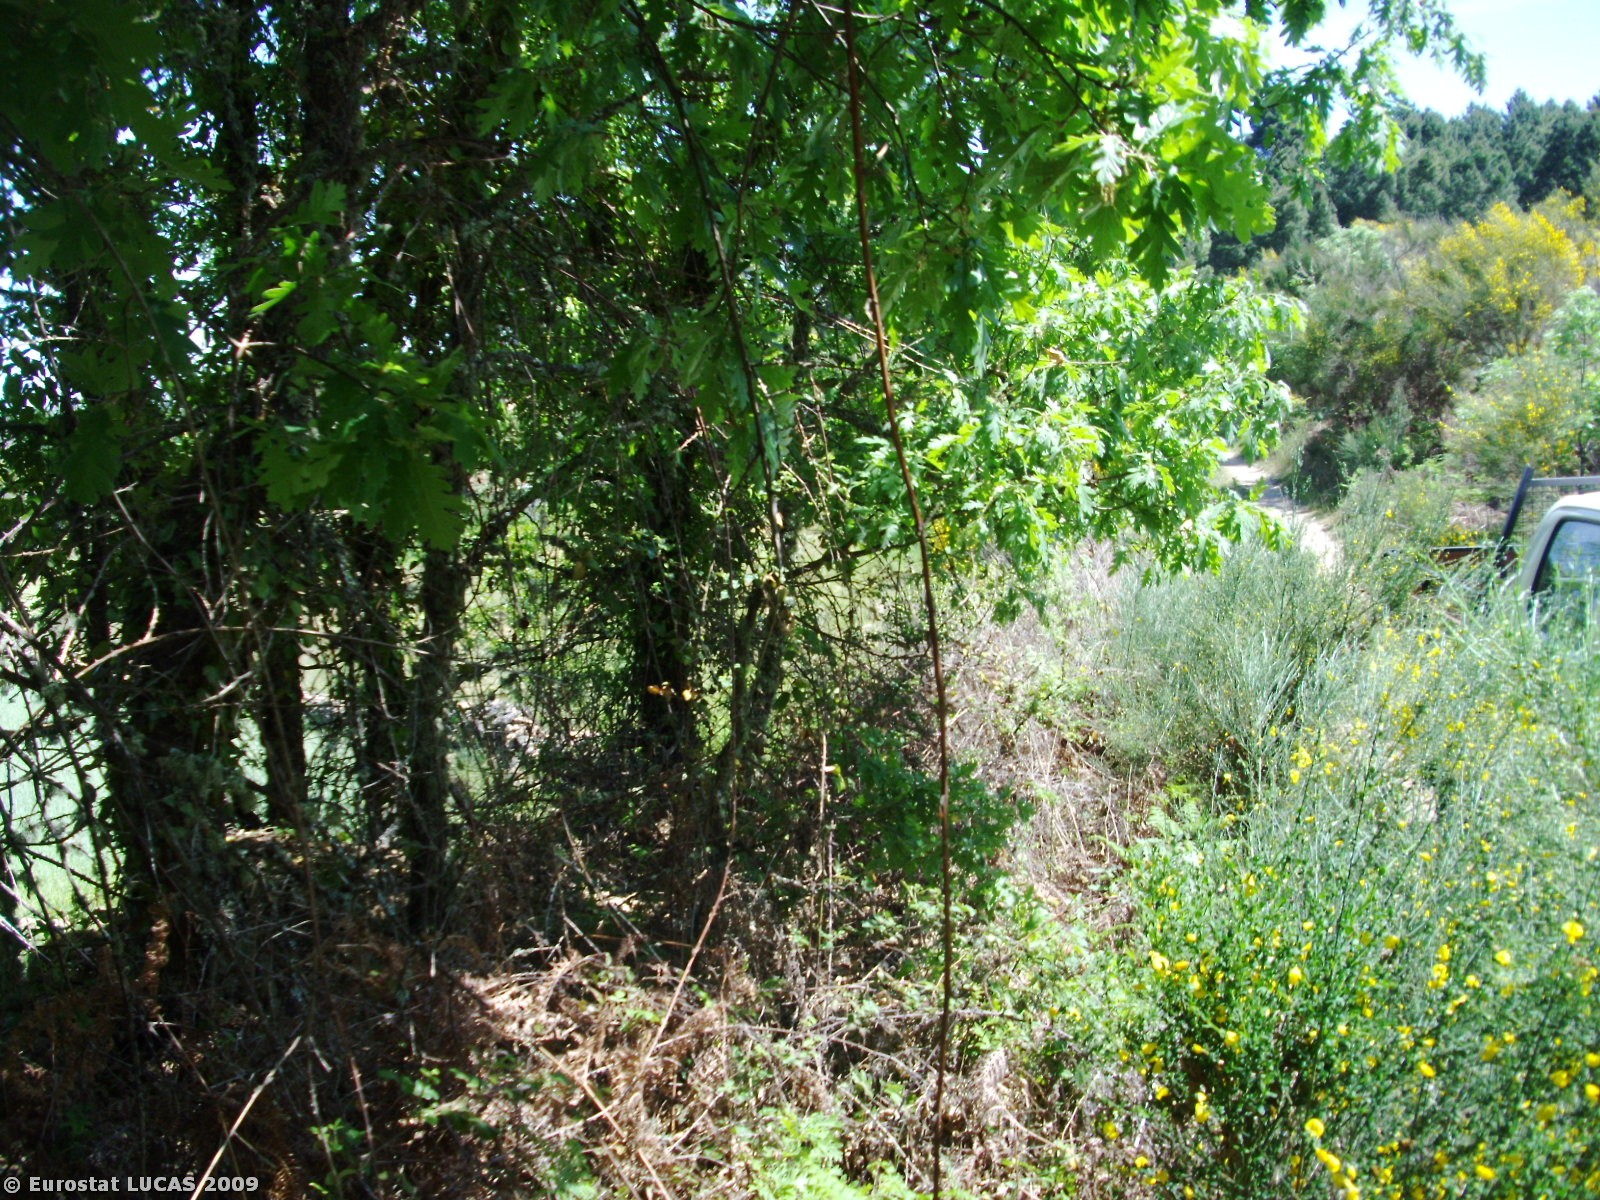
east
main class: Woodland
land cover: Broadleaved woodland
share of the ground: > 75 %
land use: Forestry
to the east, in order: Broadleaved woodland; Tracks; Shrubland without tree cover; Spontaneously vegetated surfaces; Coniferous woodland
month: May
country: PT
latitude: 40.7825
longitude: -7.3046
